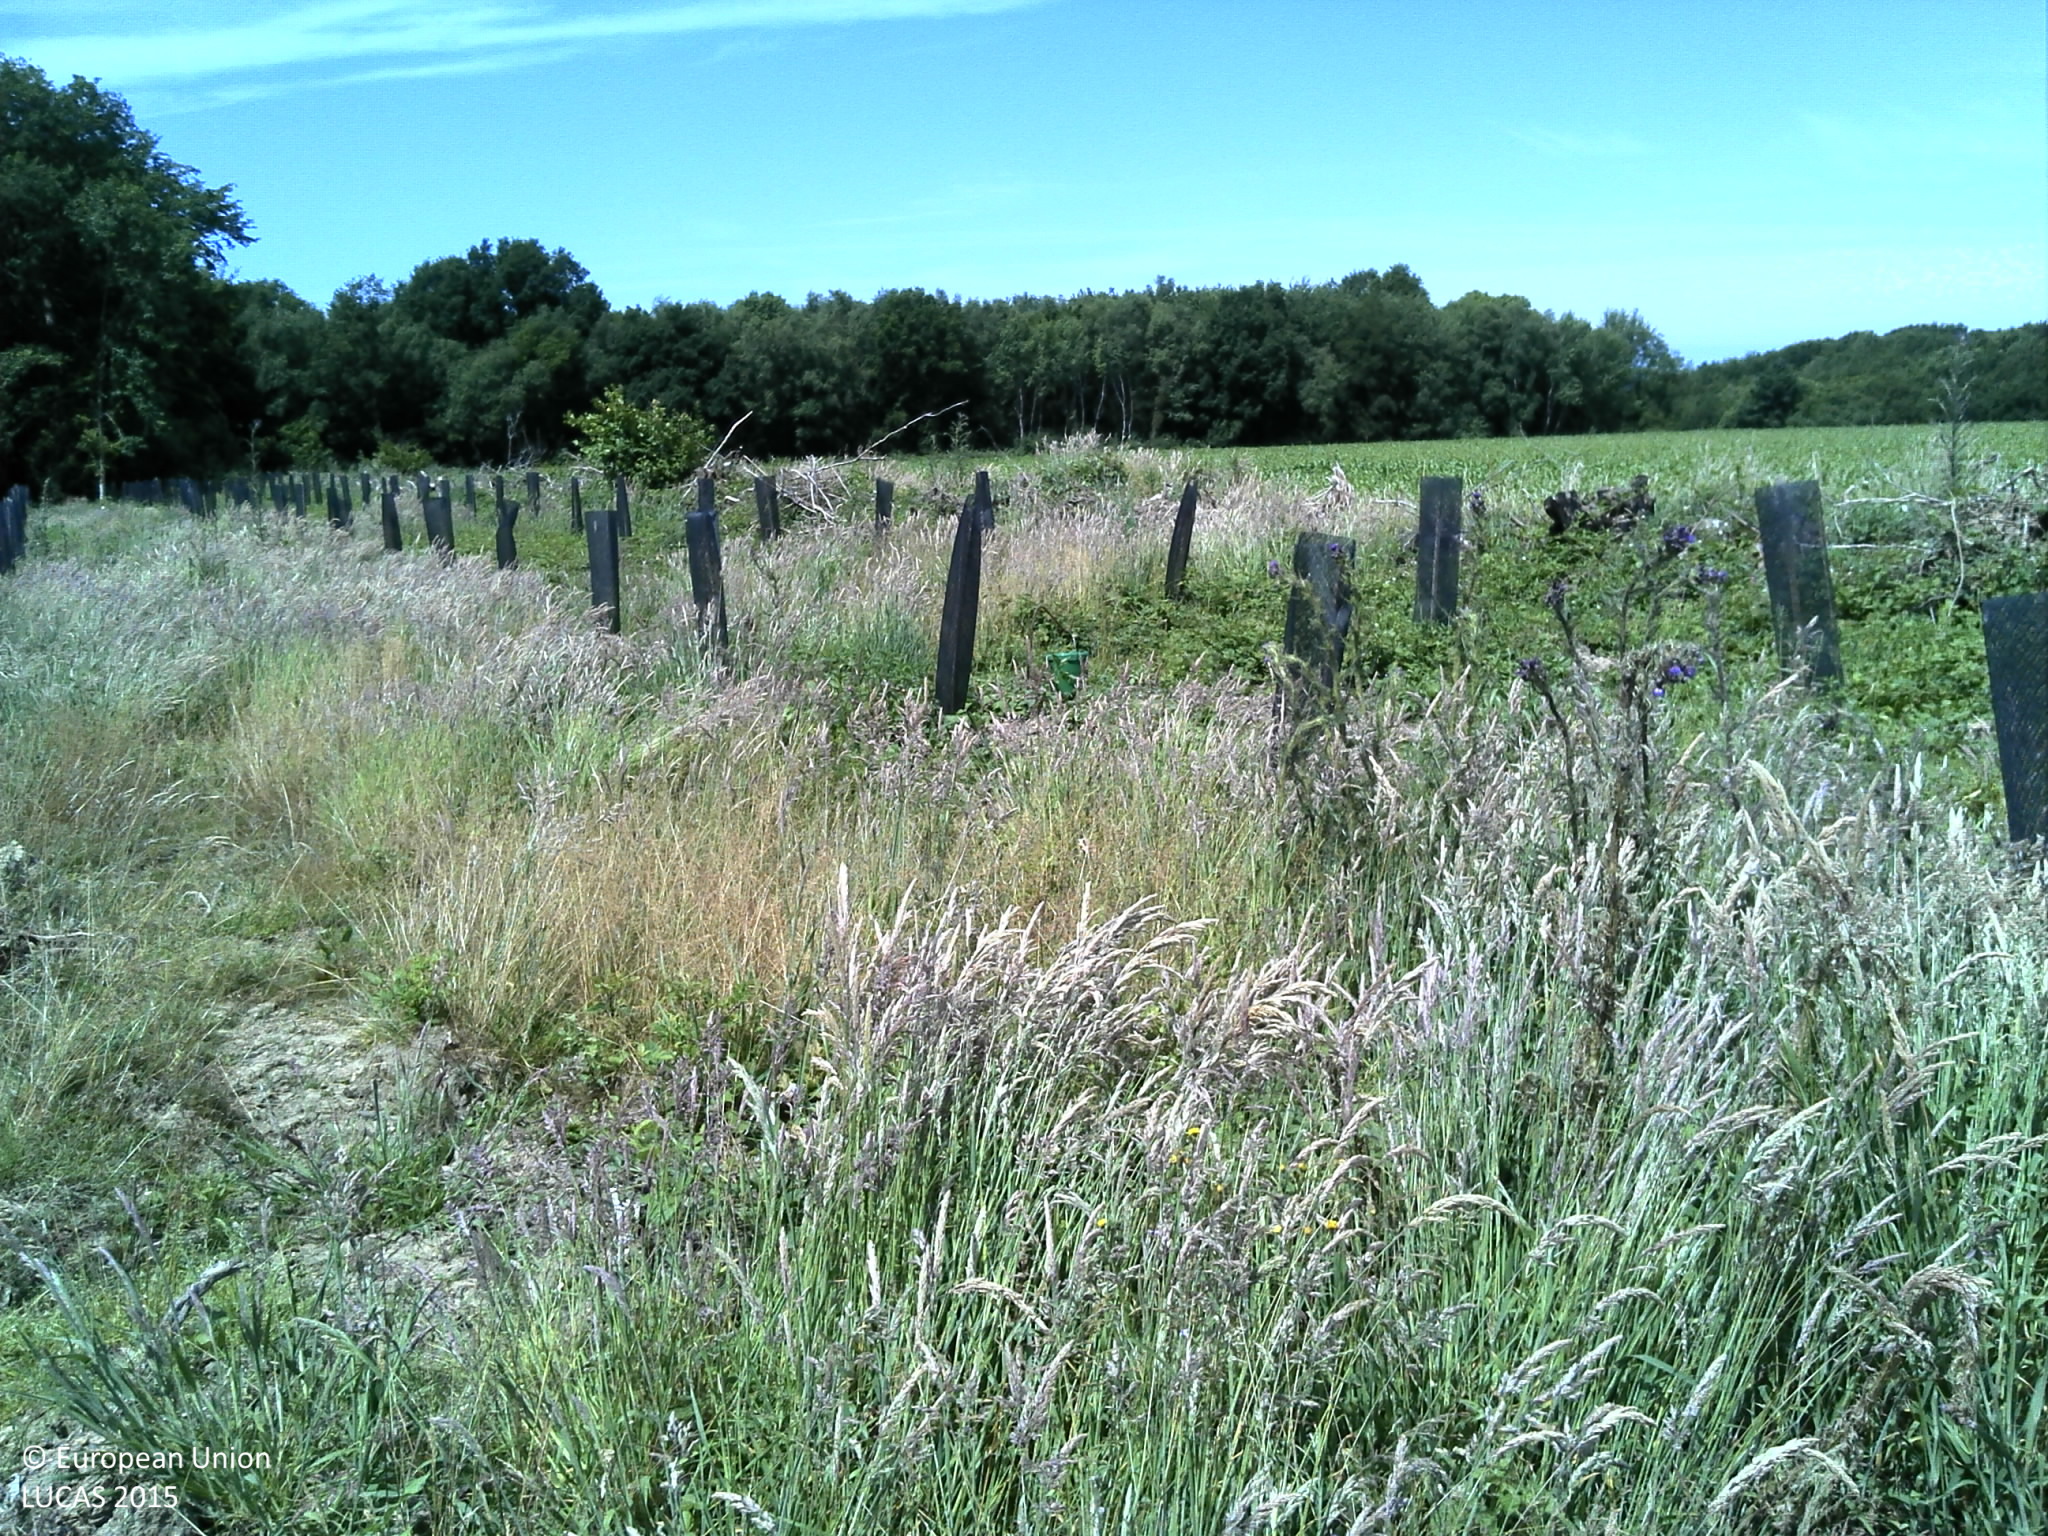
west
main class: Cropland
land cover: Nurseries
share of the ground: < 10 %
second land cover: Spontaneously vegetated surfaces
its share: > 75 %
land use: Forestry
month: June
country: FR
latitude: 49.7507
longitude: 0.9415
